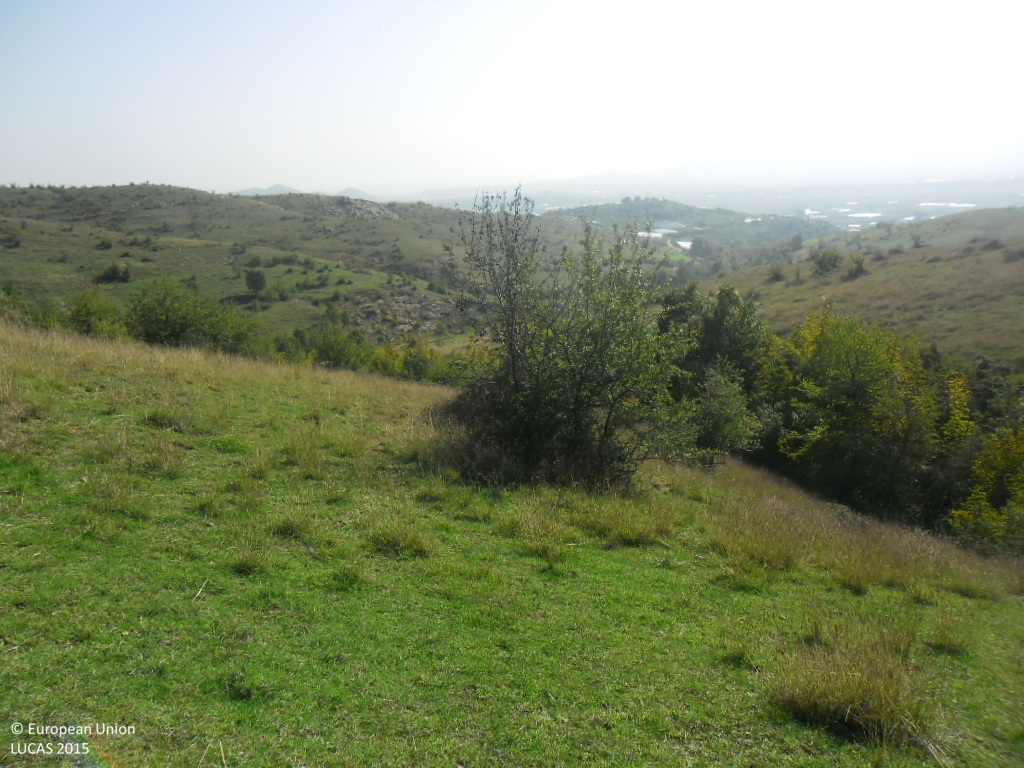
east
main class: Grassland
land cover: Grassland without tree/shrub cover
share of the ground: > 75 %
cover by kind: herbaceous plants 100 %
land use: Agriculture (excluding fallow land and kitchen gardens)
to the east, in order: Grassland without tree/shrub cover; Shrubland with sparse tree cover; Grassland without tree/shrub cover; Broadleaved woodland; Inland salty running water; Broadleaved woodland; Grassland with sparse tree/shrub cover
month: October
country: BG
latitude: 41.4600
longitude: 23.1767
